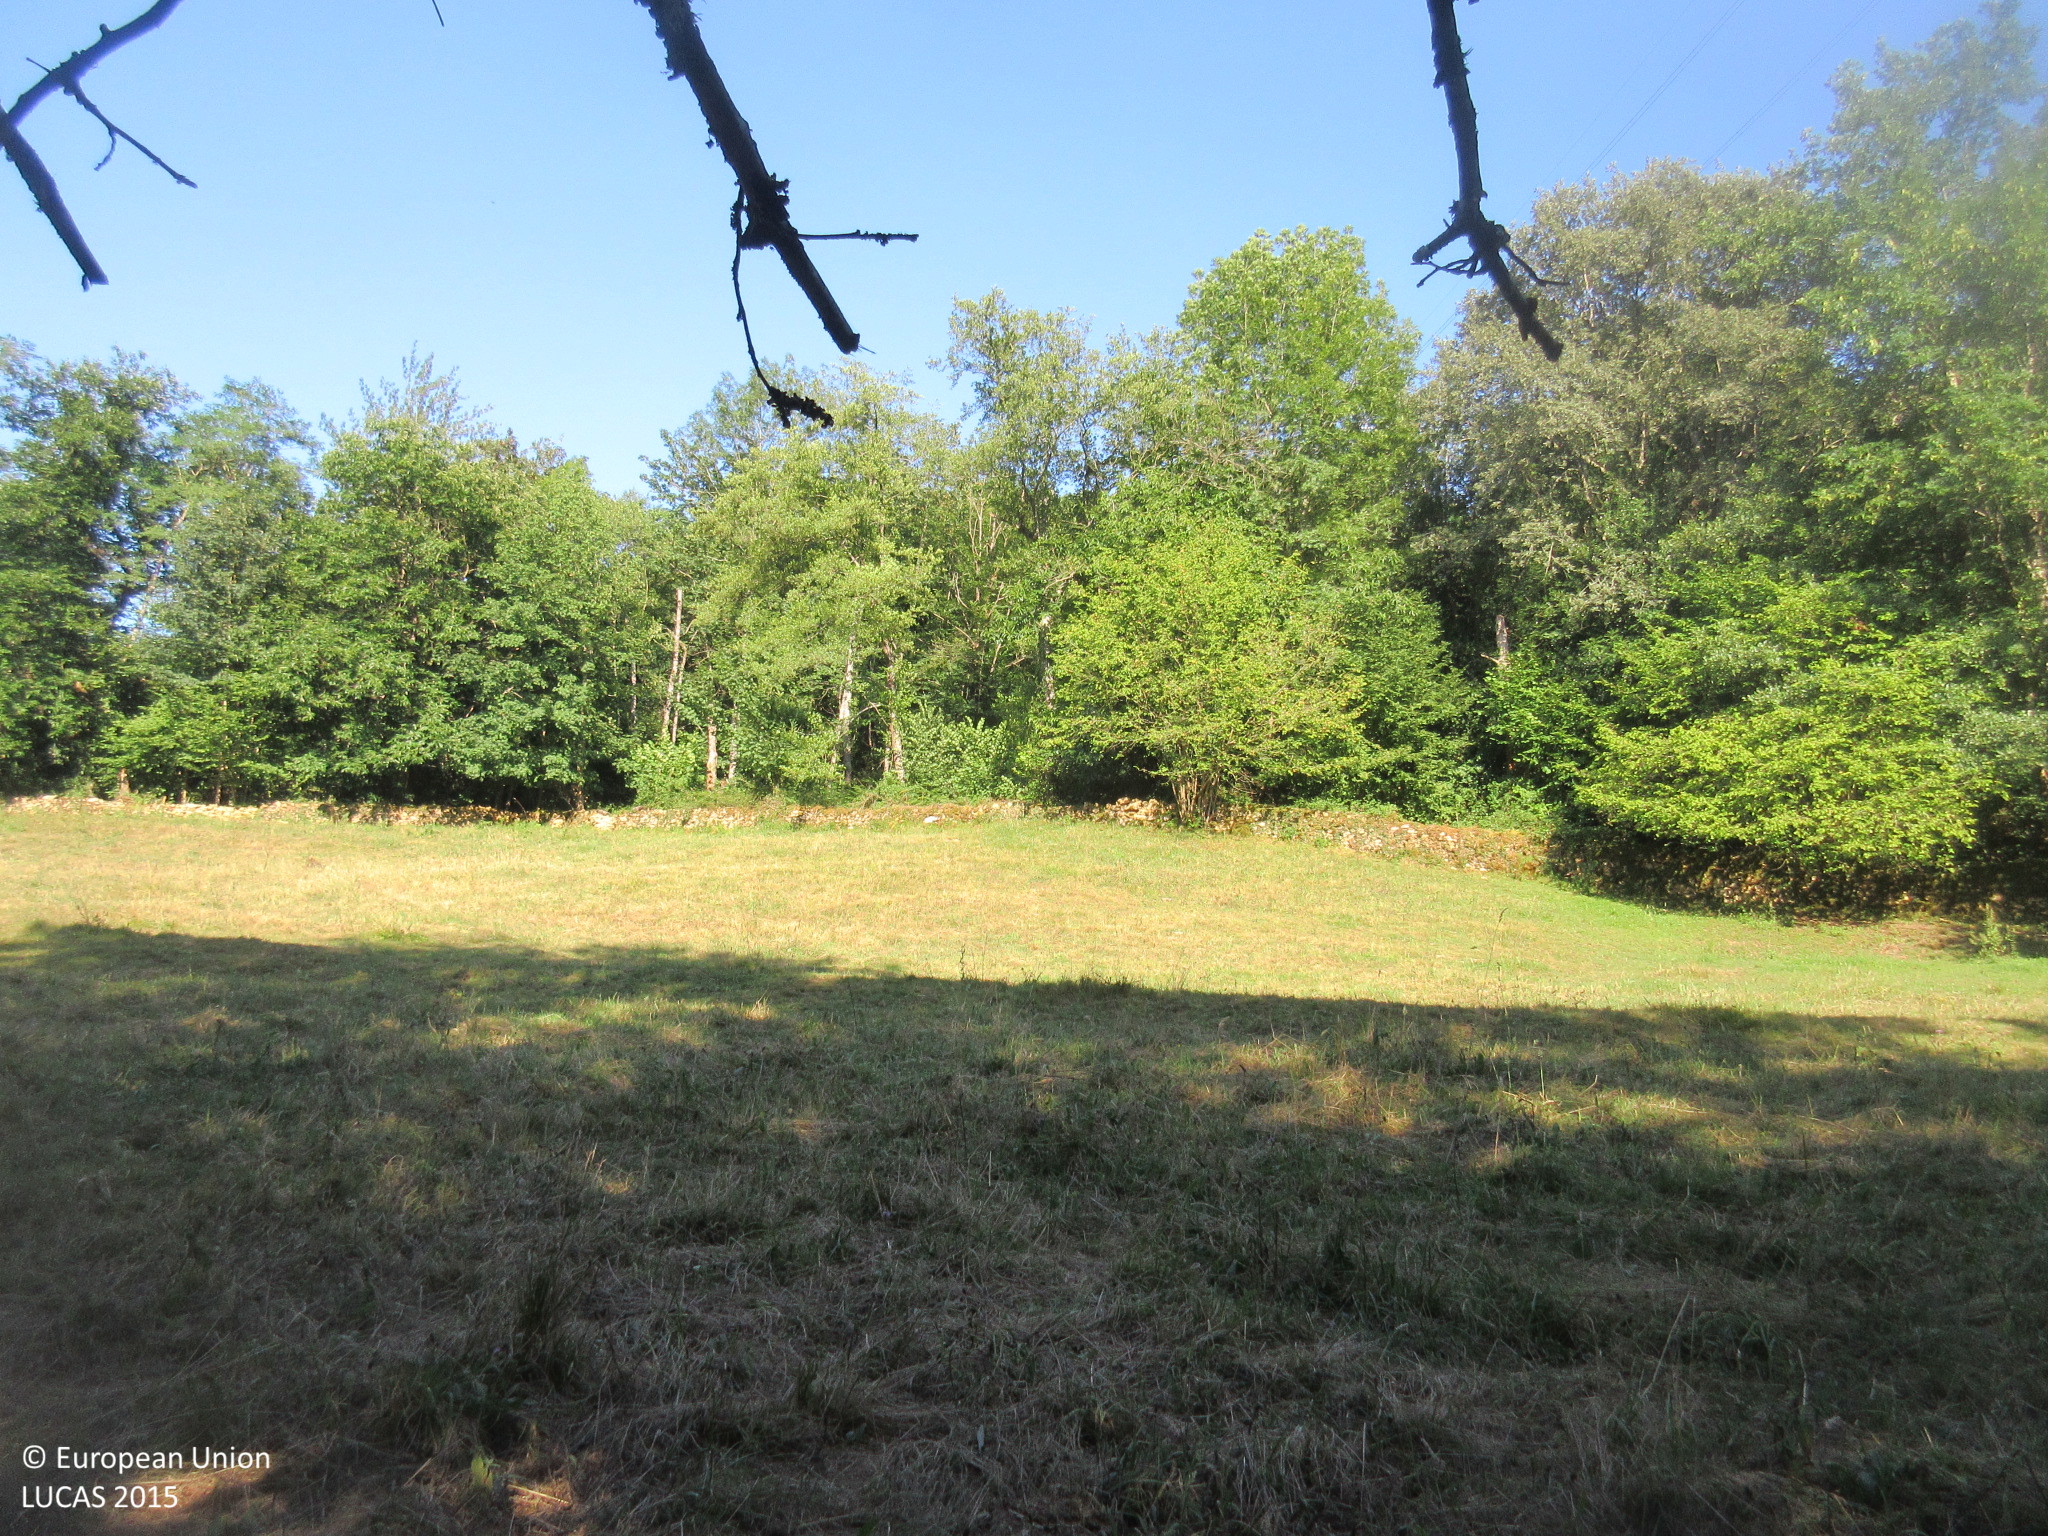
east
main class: Grassland
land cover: Grassland without tree/shrub cover
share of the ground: > 75 %
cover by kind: herbaceous plants 100 %
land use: Agriculture (excluding fallow land and kitchen gardens)
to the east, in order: Grassland without tree/shrub cover; Dry stone walls; Tracks; Broadleaved woodland; Grassland without tree/shrub cover
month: July
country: ES
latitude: 43.3537
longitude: -5.0612
